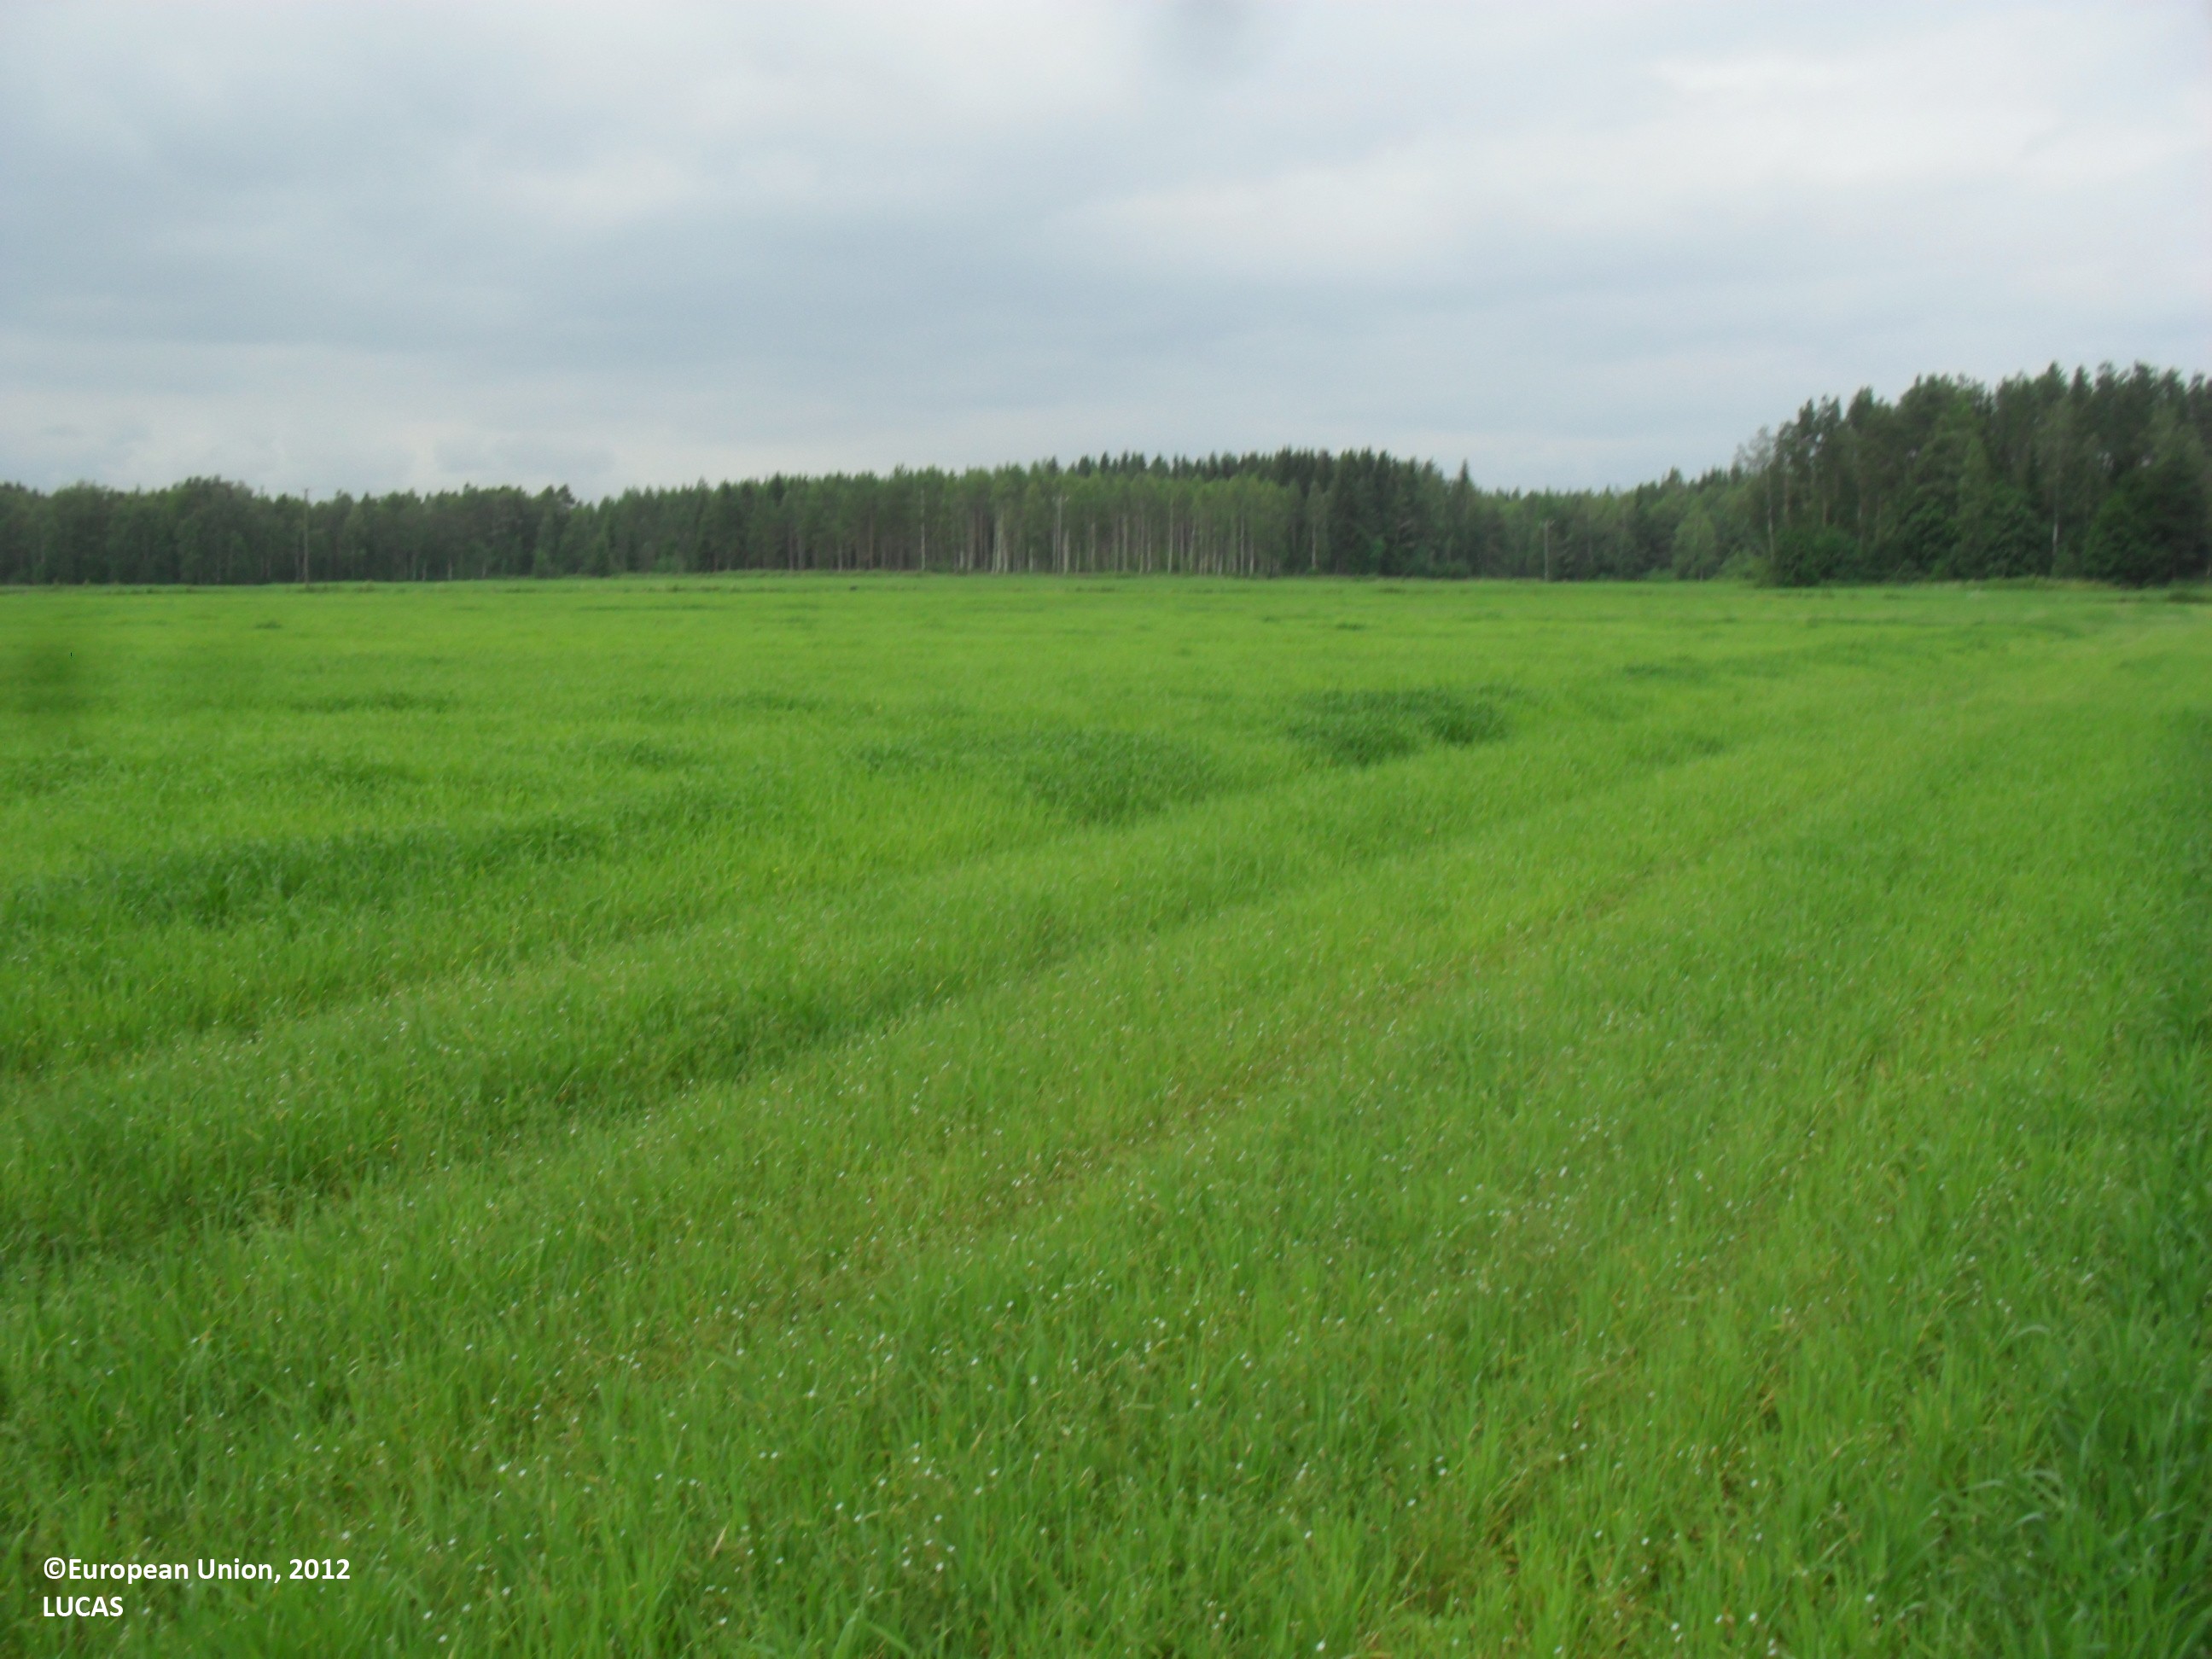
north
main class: Cropland
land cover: Barley
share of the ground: > 75 %
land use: Agriculture (excluding fallow land and kitchen gardens)
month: July
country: FI
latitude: 63.5971
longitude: 23.5053
